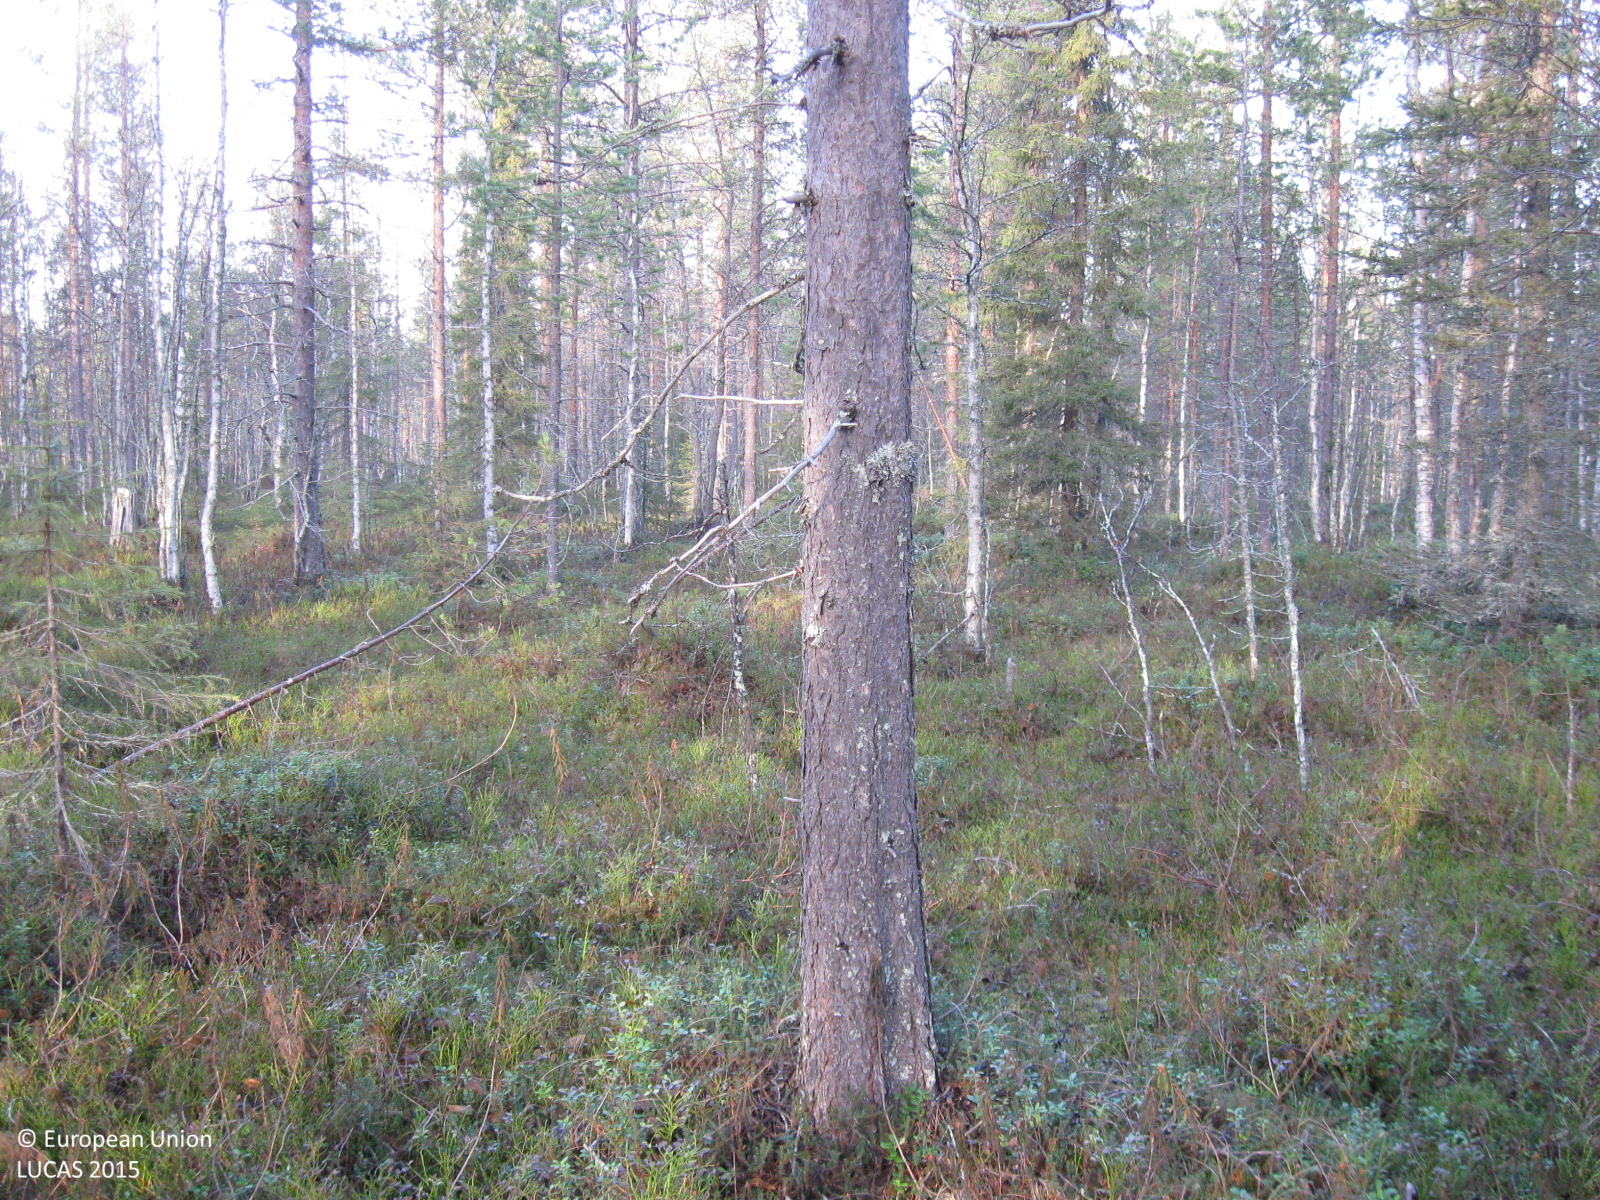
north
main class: Woodland
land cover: Pine dominated mixed woodland
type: boreal forest
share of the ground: > 75 %
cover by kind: coniferous forest trees 60 %, broadleaved forest trees 20 %, shrubs 10 %, herbaceous plants 5 %, lichens and mosses 5 %
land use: Forestry
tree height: > 5 m
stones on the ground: 10 - 25 %
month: October
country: SE
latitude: 66.2198
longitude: 22.1733
